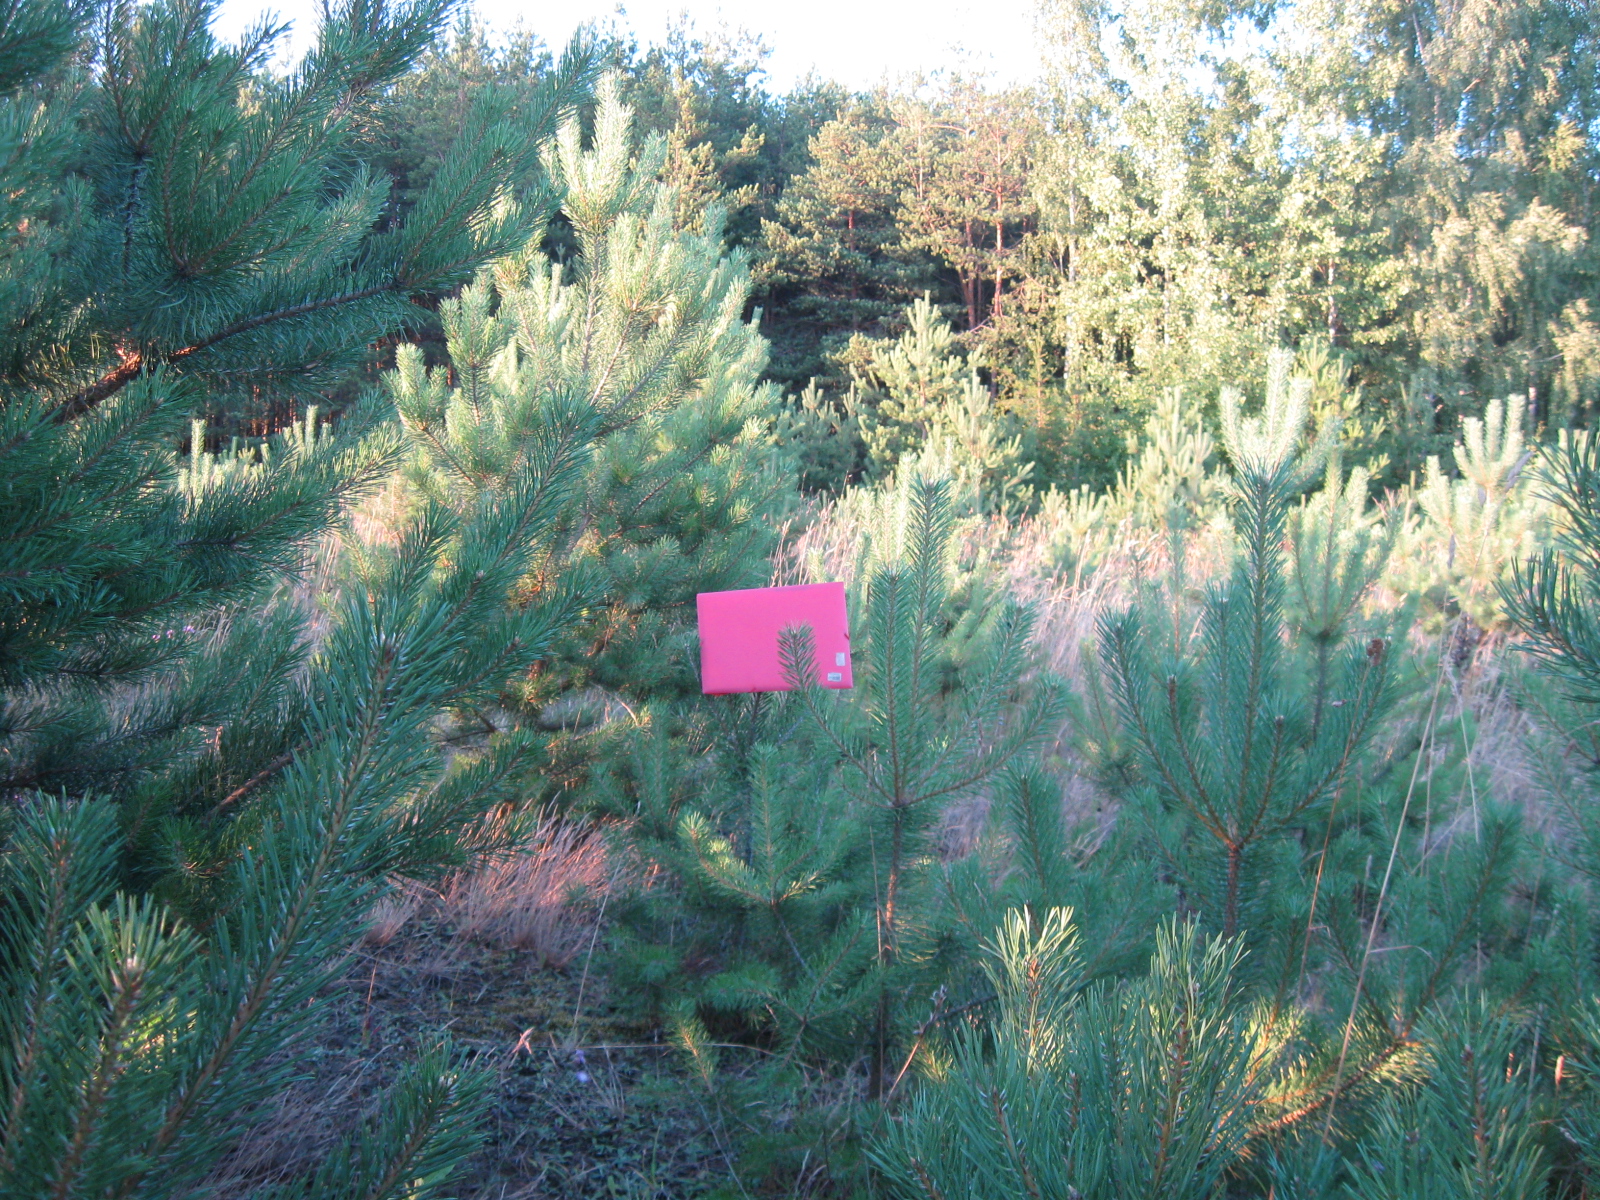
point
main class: Woodland
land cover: Pine dominated coniferous woodland
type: hemiboreal forest and nemoral coniferous forest and mixed broadleaved-coniferous forest
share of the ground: 25 - 50 %
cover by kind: herbaceous plants 55 %, coniferous forest trees 45 %
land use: Forestry
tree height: < 5 m
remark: Nursery
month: July
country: LT
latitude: 54.0956
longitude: 23.7110
